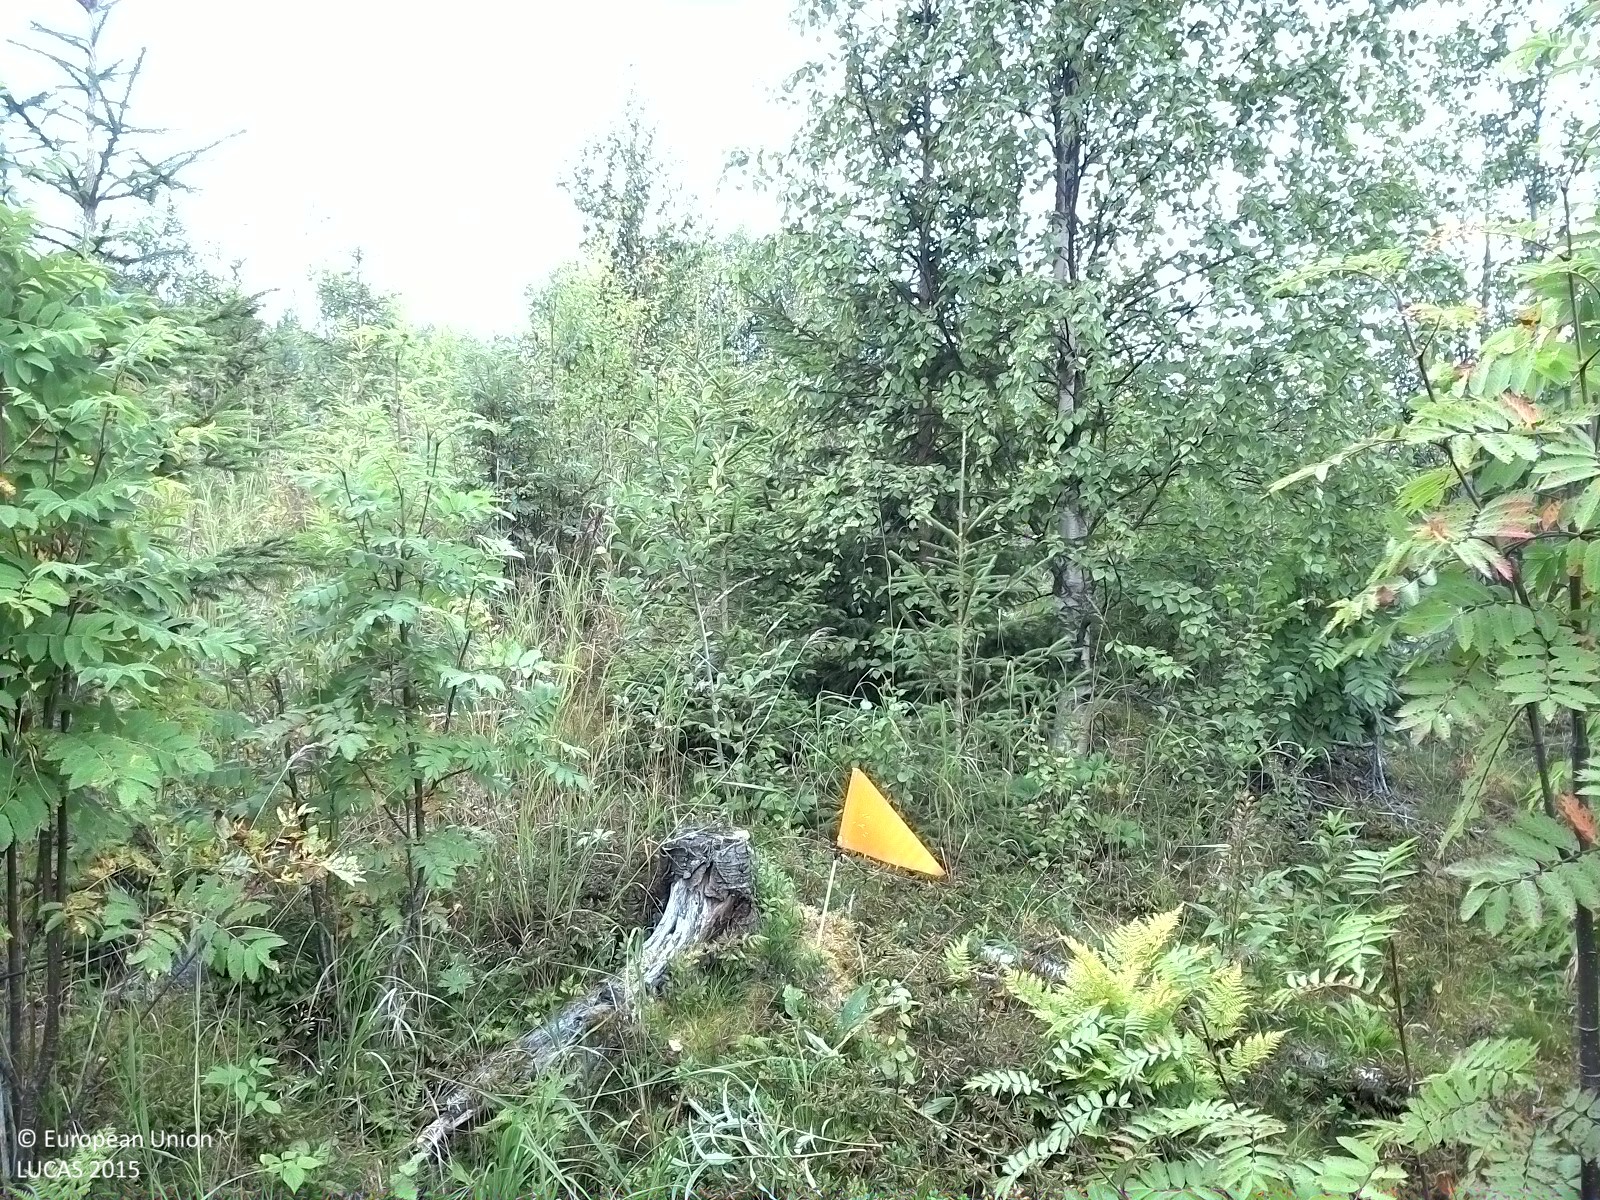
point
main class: Woodland
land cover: Spruce dominated mixed woodland
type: boreal forest
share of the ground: 25 - 50 %
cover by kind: herbaceous plants 40 %, broadleaved forest trees 35 %, coniferous forest trees 15 %, shrubs 10 %
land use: Forestry
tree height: < 5 m
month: August
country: SE
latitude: 62.2675
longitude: 16.2022
